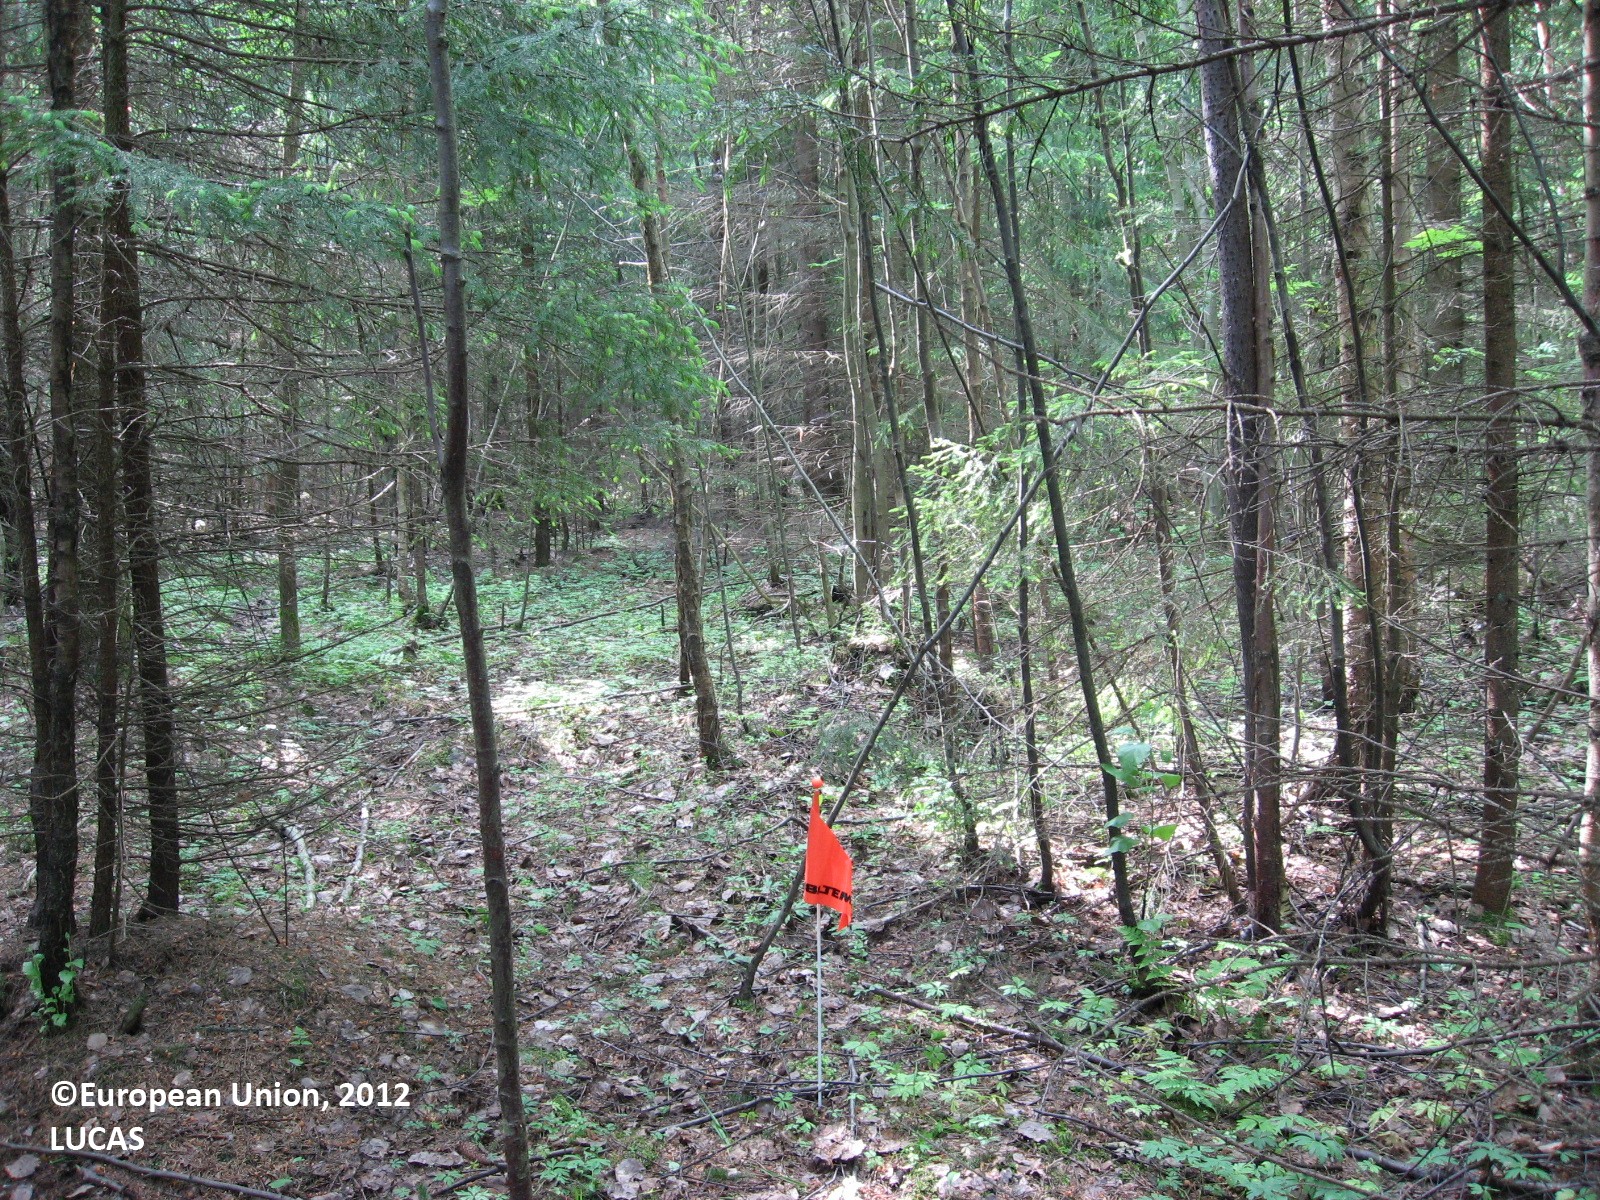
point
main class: Woodland
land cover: Spruce dominated coniferous woodland
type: boreal forest
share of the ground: > 75 %
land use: Forestry
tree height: > 5 m
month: June
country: FI
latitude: 60.3539
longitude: 24.9241
